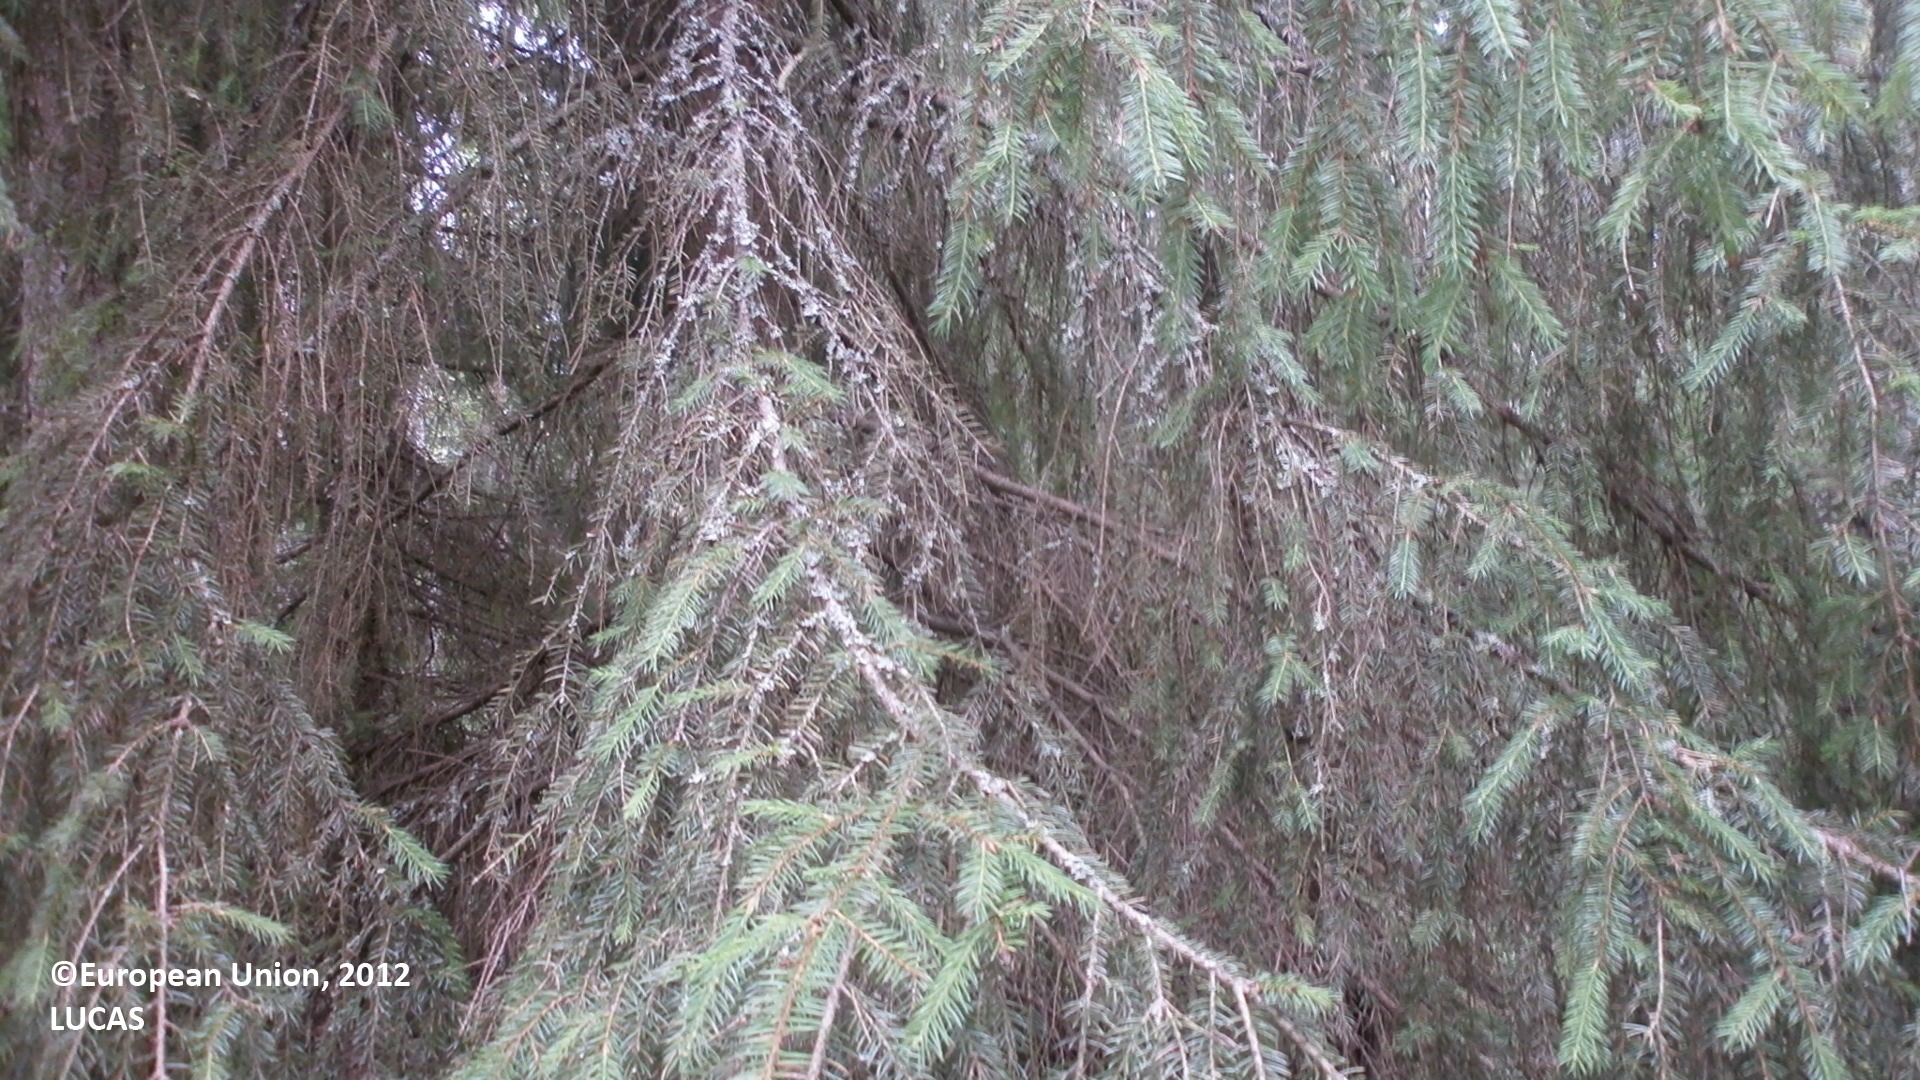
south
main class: Woodland
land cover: Spruce dominated mixed woodland
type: boreal forest
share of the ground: > 75 %
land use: Forestry
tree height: > 5 m
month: July
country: FI
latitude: 64.2210
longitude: 24.1413
